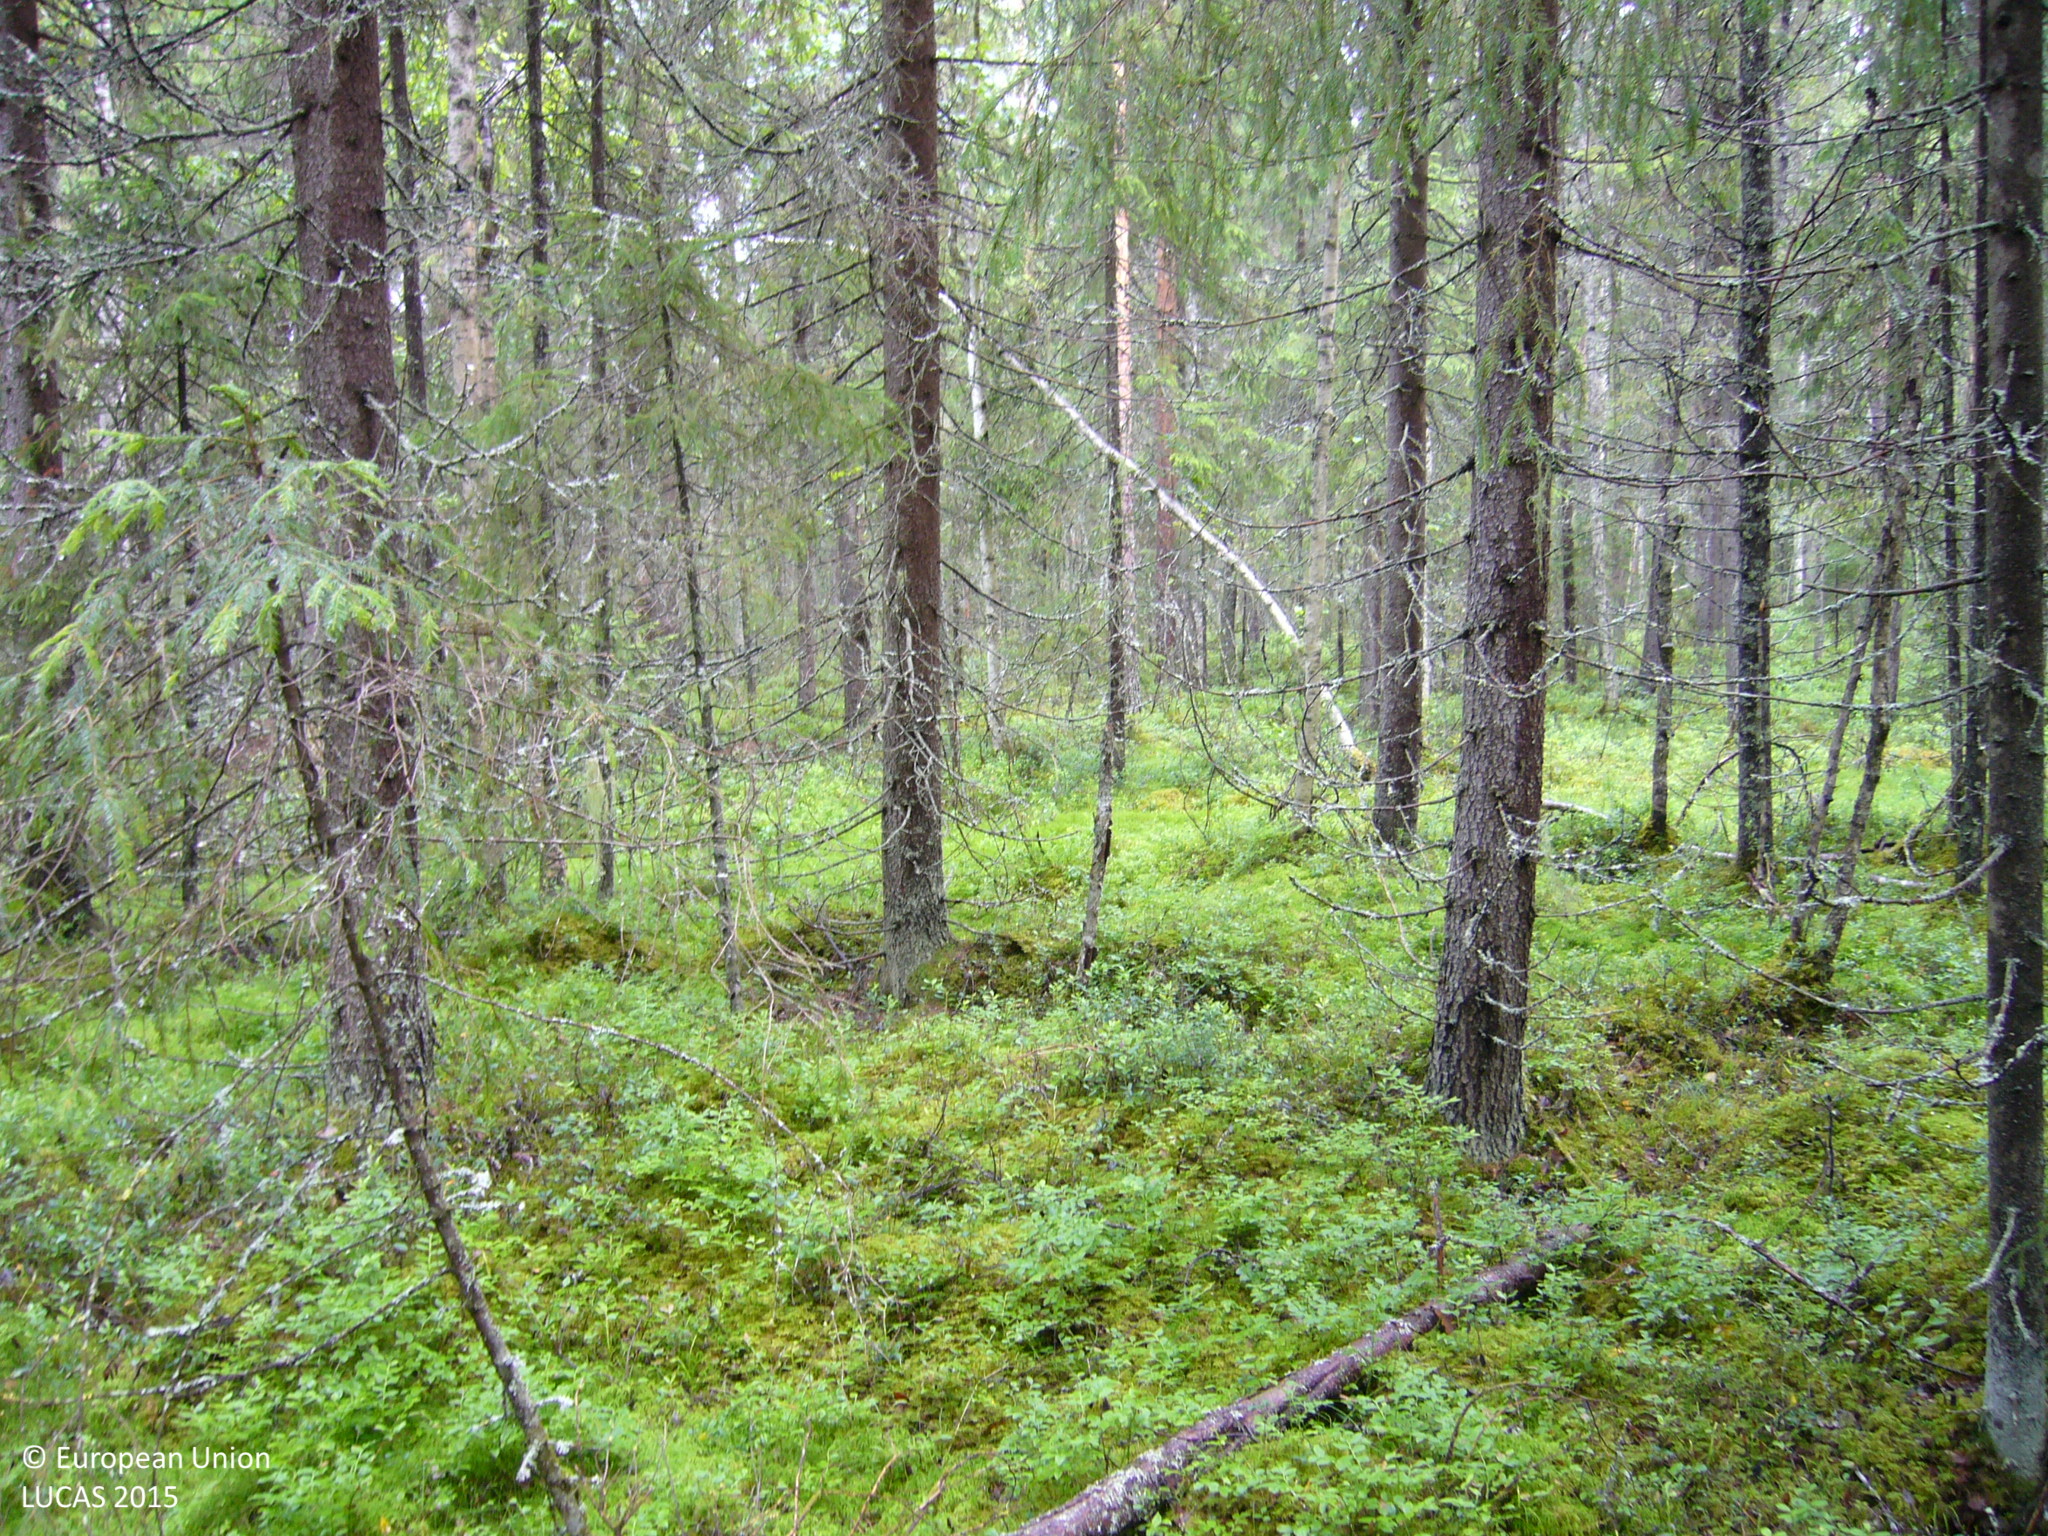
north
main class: Woodland
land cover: Spruce dominated mixed woodland
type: boreal forest
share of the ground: > 75 %
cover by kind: coniferous forest trees 50 %, broadleaved forest trees 30 %, shrubs 20 %
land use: Forestry
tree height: > 5 m
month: July
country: FI
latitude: 63.8832
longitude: 25.5523
